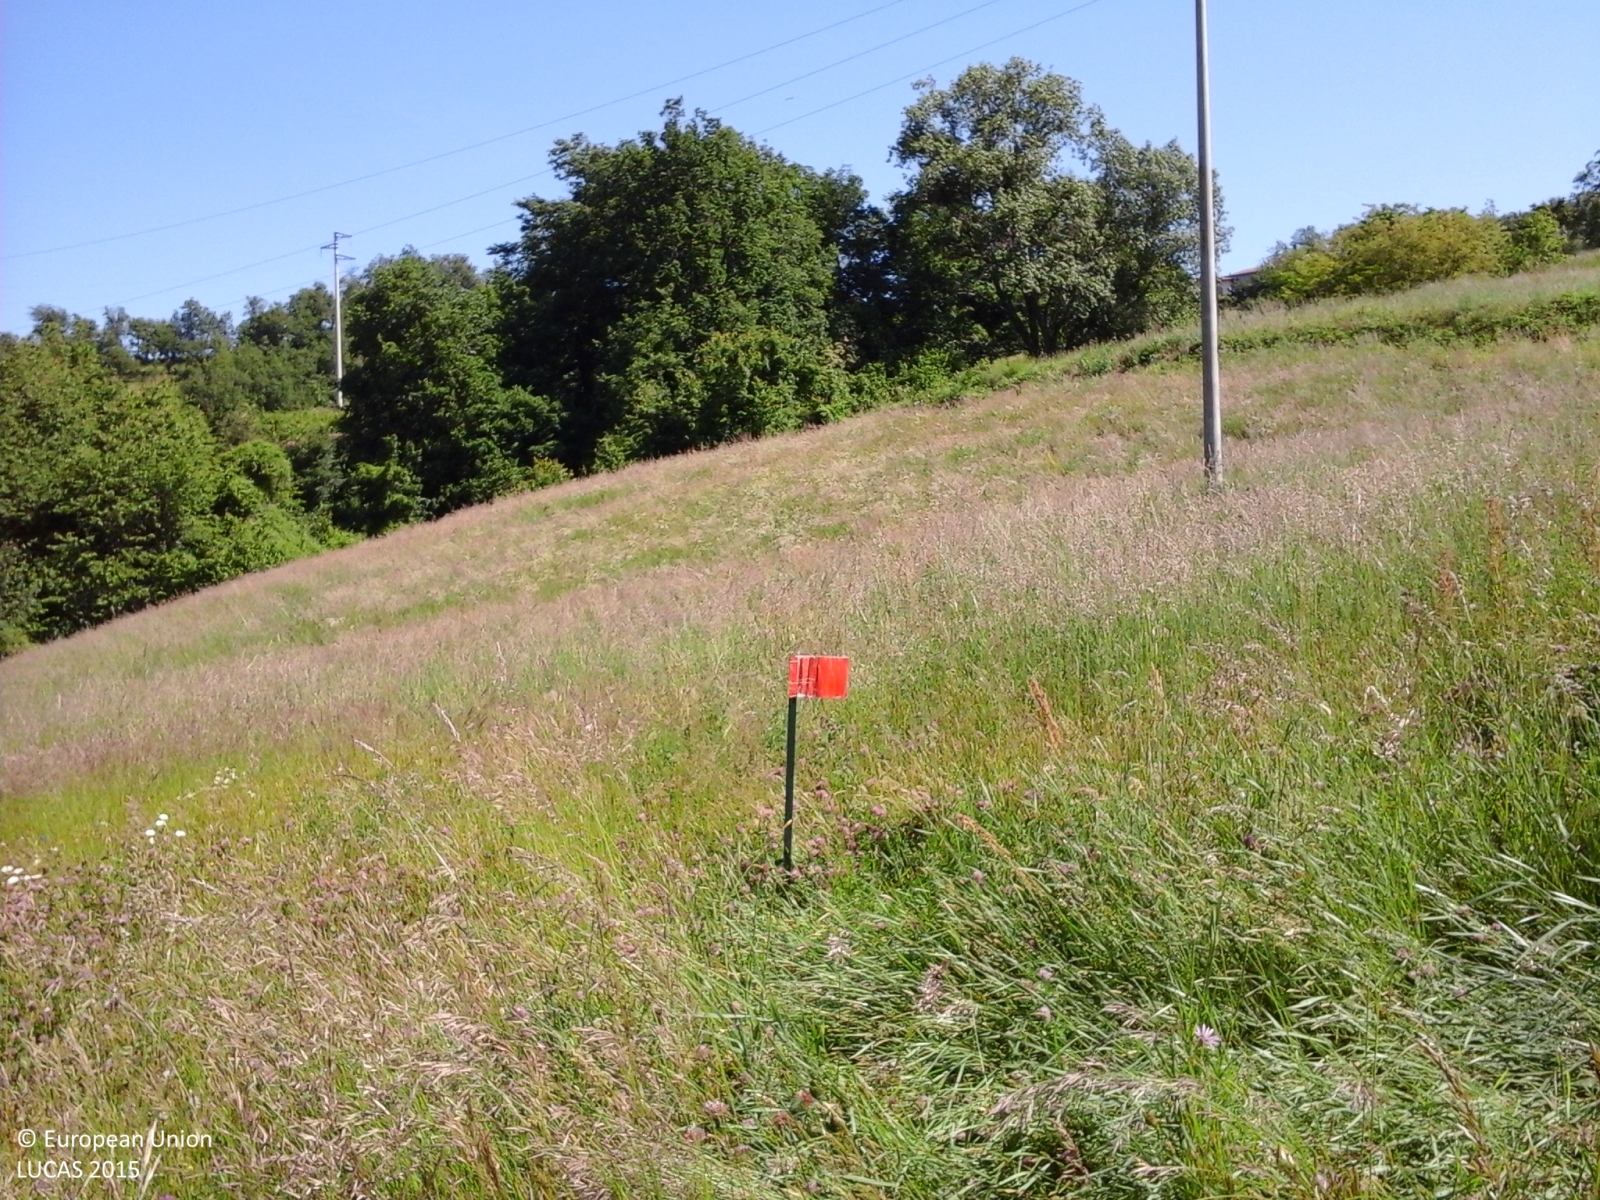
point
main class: Grassland
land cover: Grassland without tree/shrub cover
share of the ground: > 75 %
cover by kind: herbaceous plants 100 %
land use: Agriculture (excluding fallow land and kitchen gardens)
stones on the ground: < 10 %
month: May
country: IT
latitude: 44.3665
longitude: 10.6635
